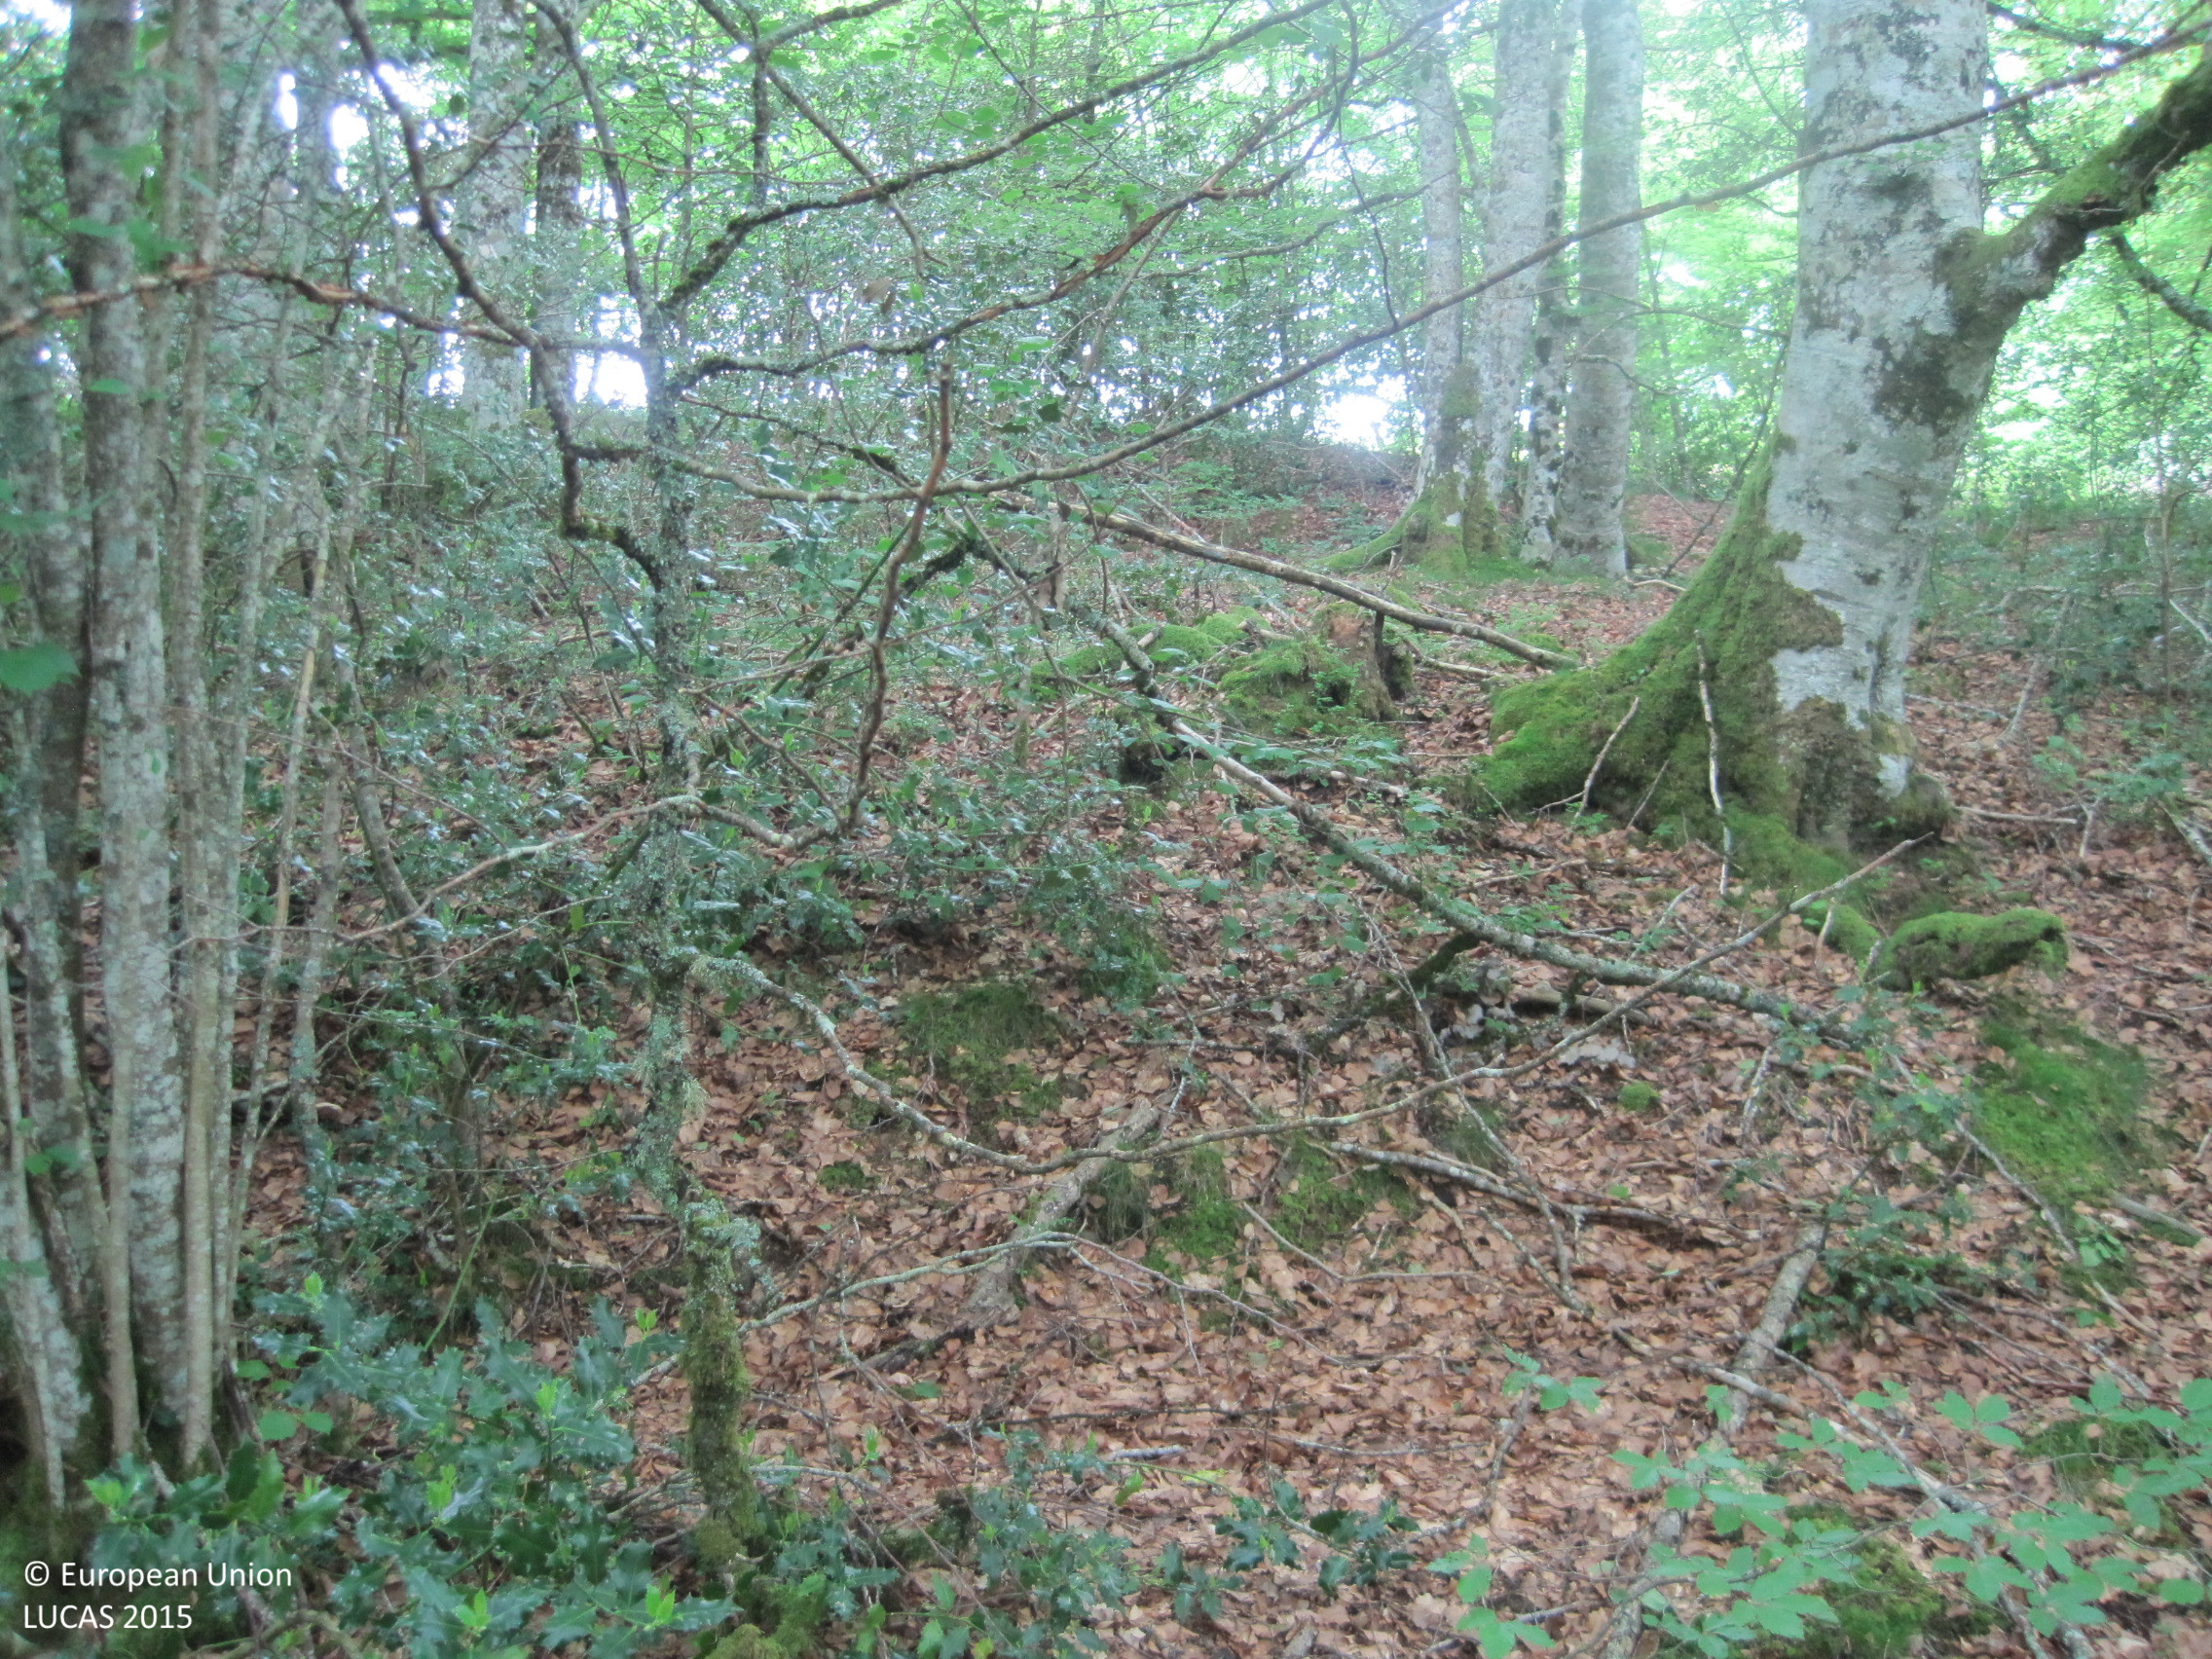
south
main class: Woodland
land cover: Broadleaved woodland
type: beech forest
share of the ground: > 75 %
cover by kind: broadleaved forest trees 100 %
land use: Forestry
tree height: > 5 m
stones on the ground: < 10 %
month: May
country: ES
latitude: 43.0019
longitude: -1.3108
